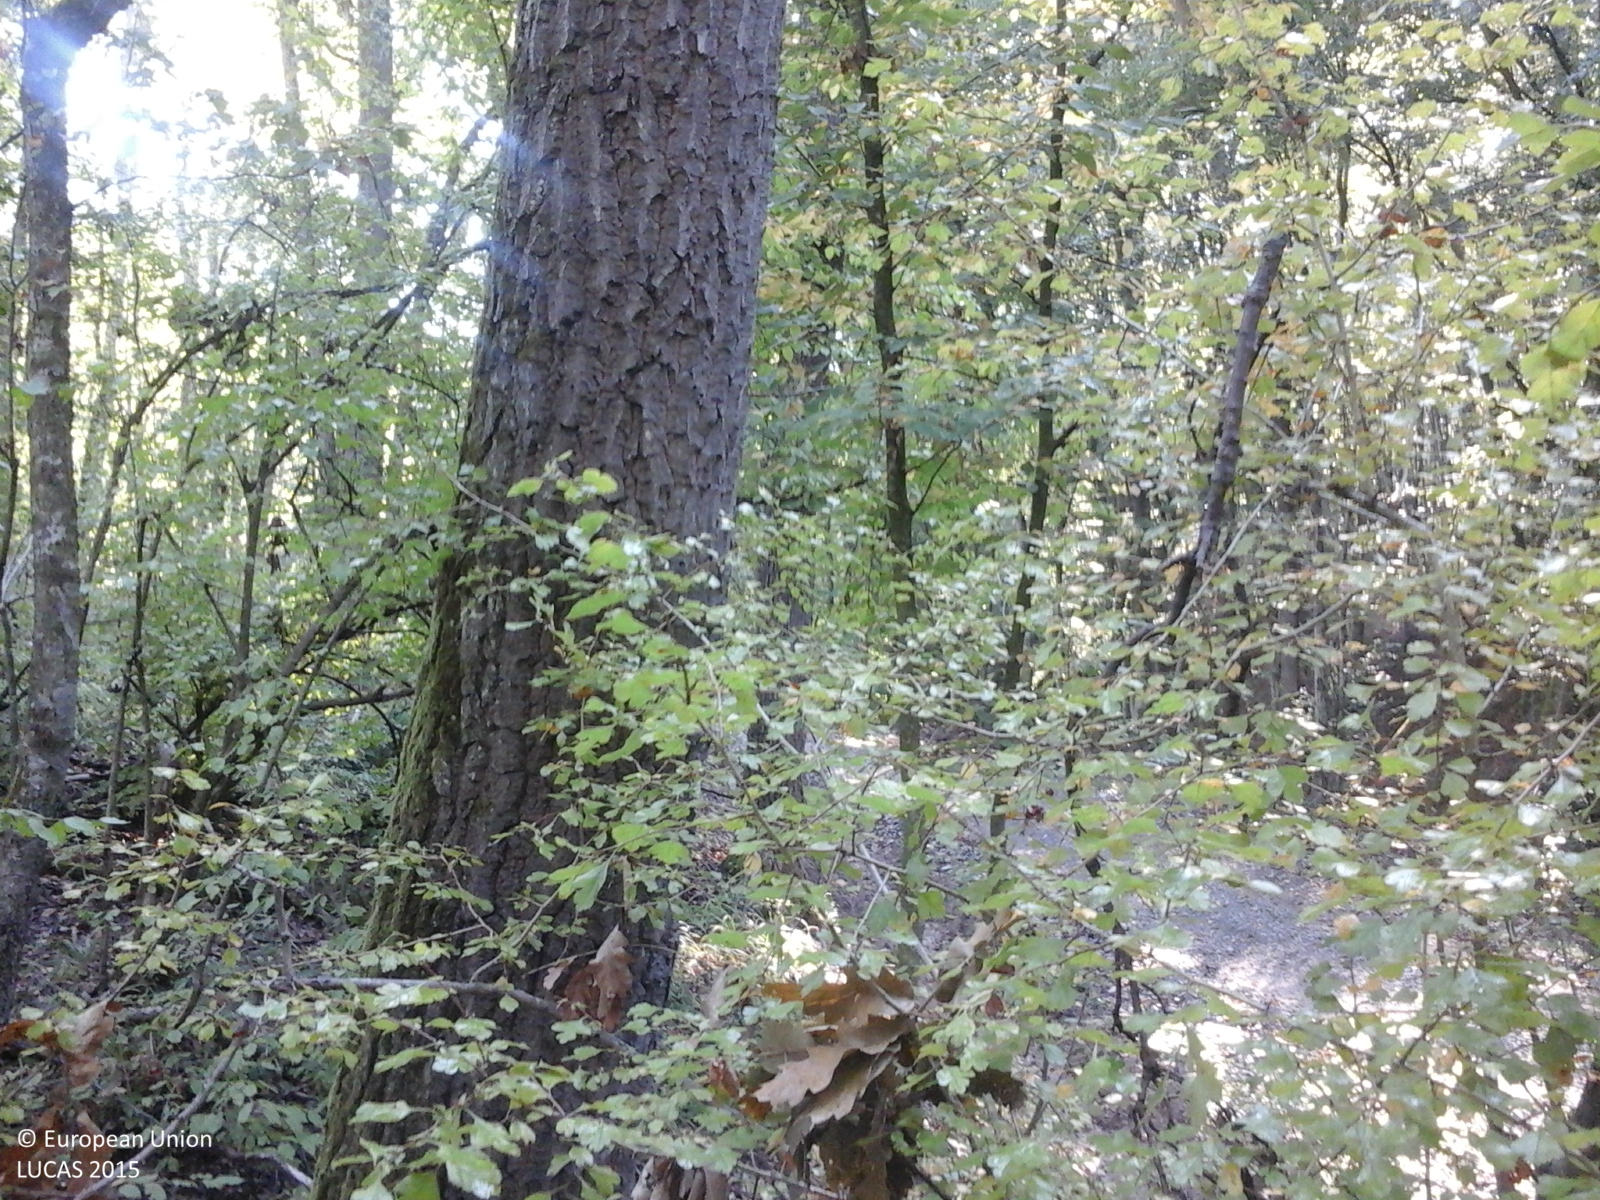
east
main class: Woodland
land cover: Broadleaved woodland
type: beech forest
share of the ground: > 75 %
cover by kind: broadleaved forest trees 100 %
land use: Forestry
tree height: > 5 m
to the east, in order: Broadleaved woodland; Tracks; Broadleaved woodland
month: September
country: RO
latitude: 47.4452
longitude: 22.8867
